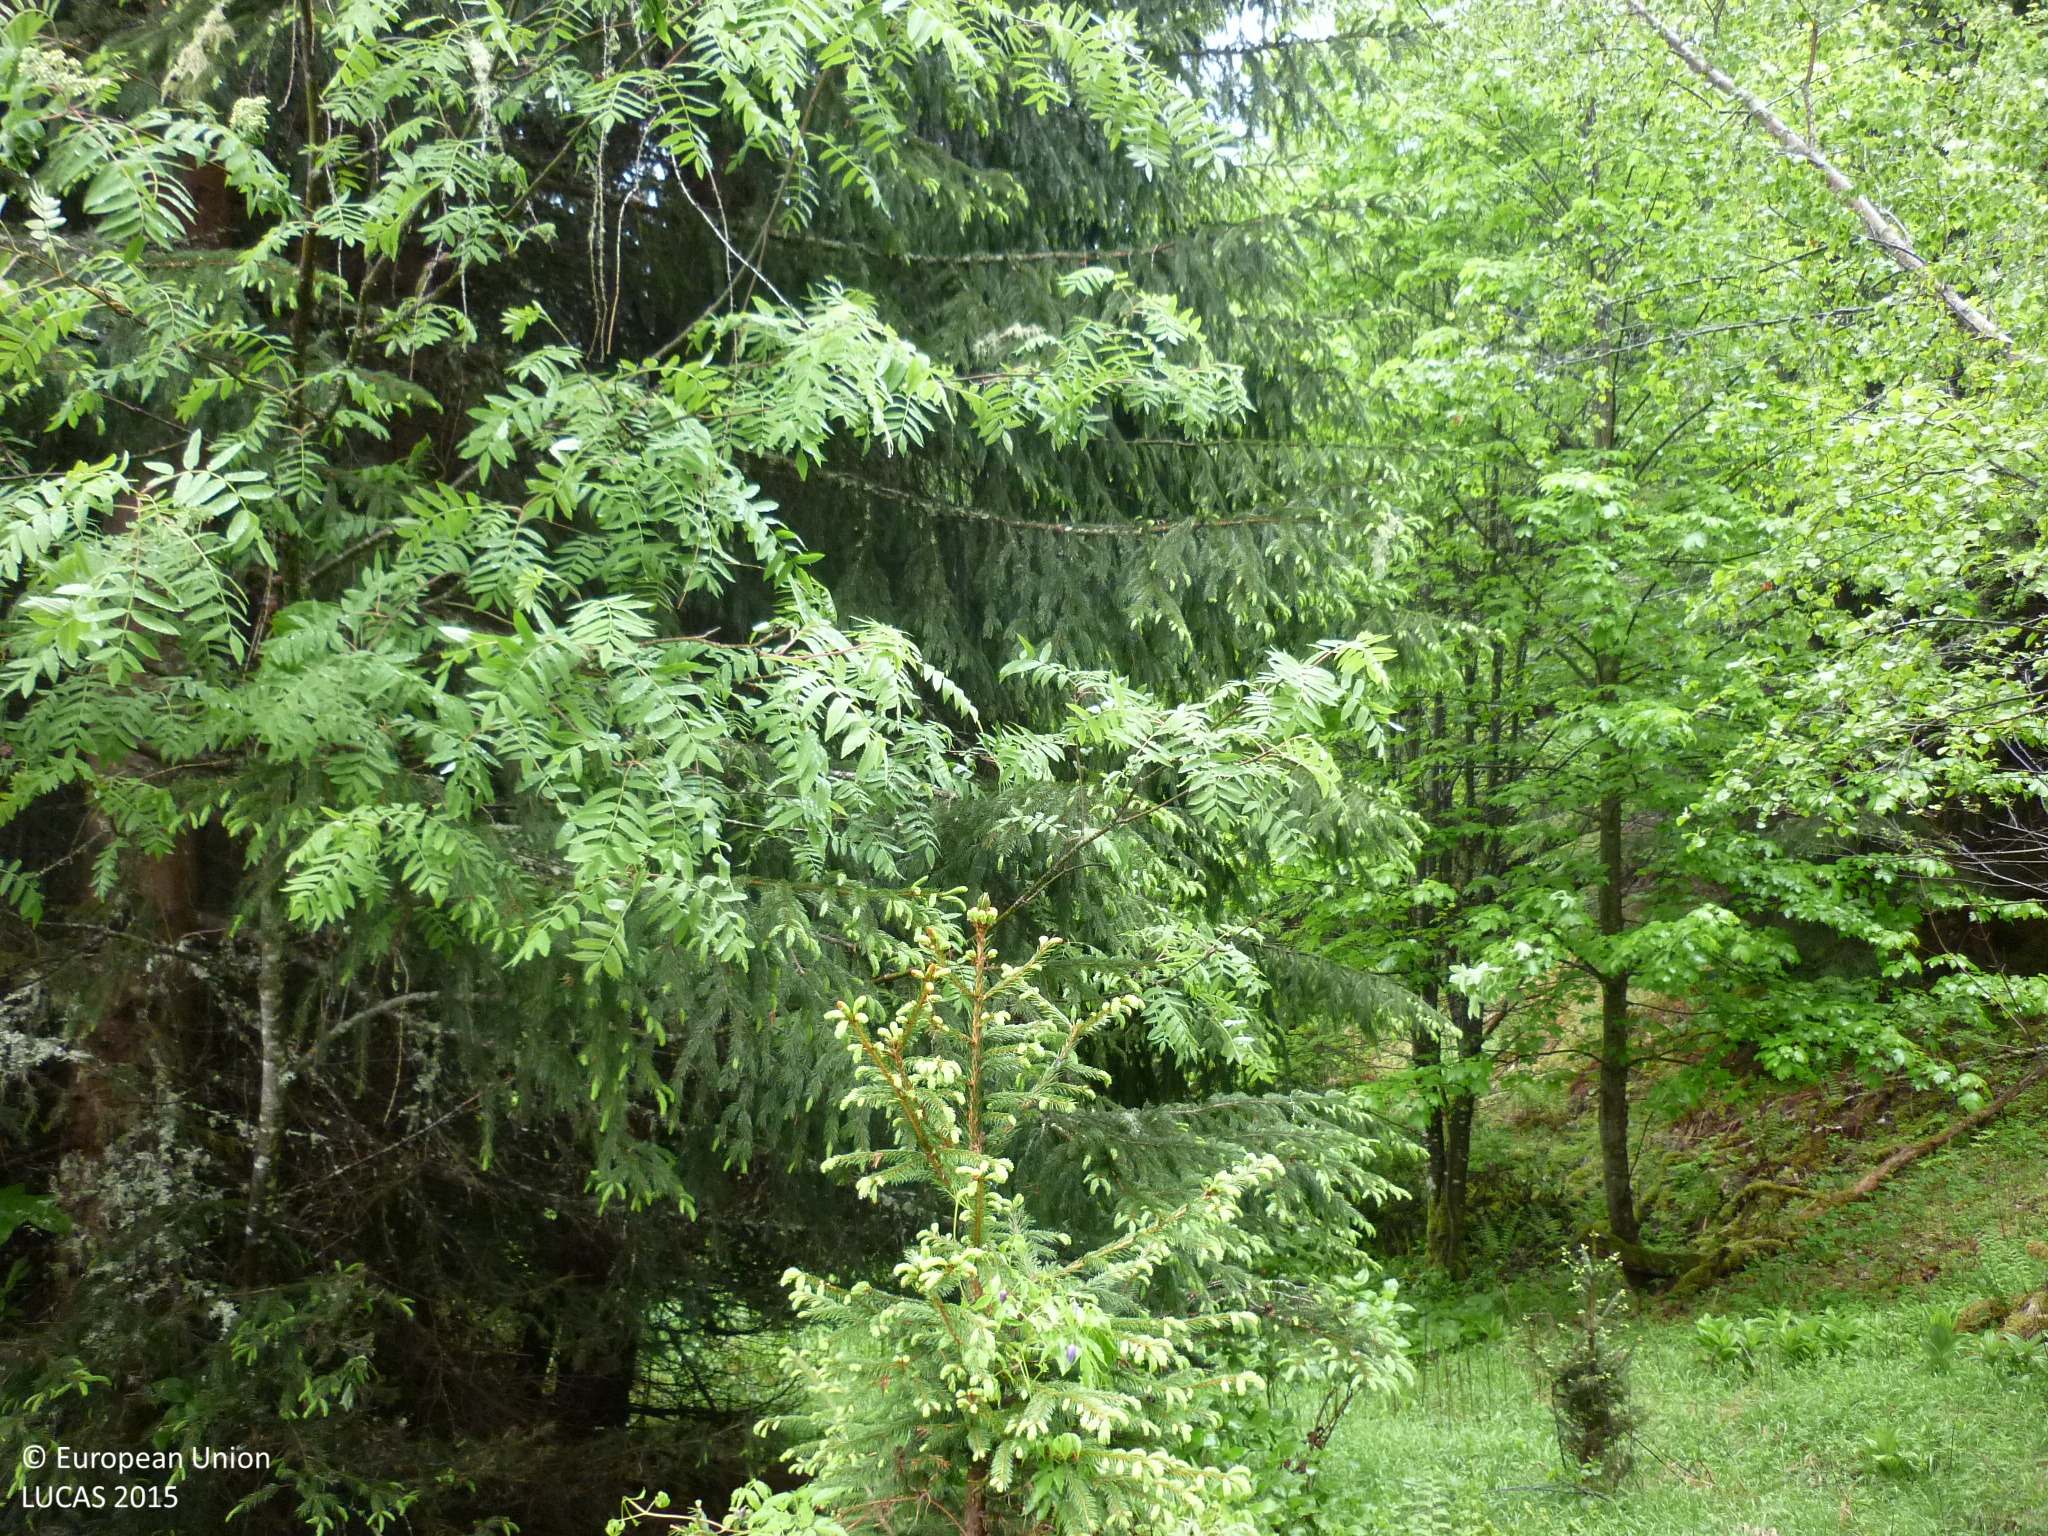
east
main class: Grassland
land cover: Grassland with sparse tree/shrub cover
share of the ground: > 75 %
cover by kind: herbaceous plants 85 %, shrubs 10 %, coniferous forest trees 5 %
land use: Forestry
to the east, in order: Grassland with sparse tree/shrub cover; Spruce dominated mixed woodland; Spruce dominated coniferous woodland; Spontaneously vegetated surfaces; Spruce dominated coniferous woodland; Grassland with sparse tree/shrub cover; Spruce dominated coniferous woodland; Rivers and streams; Spruce dominated coniferous woodland; Tracks; Grassland with sparse tree/shrub cover; Spruce dominated coniferous woodland
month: May
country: AT
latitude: 47.1002
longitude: 14.1485
